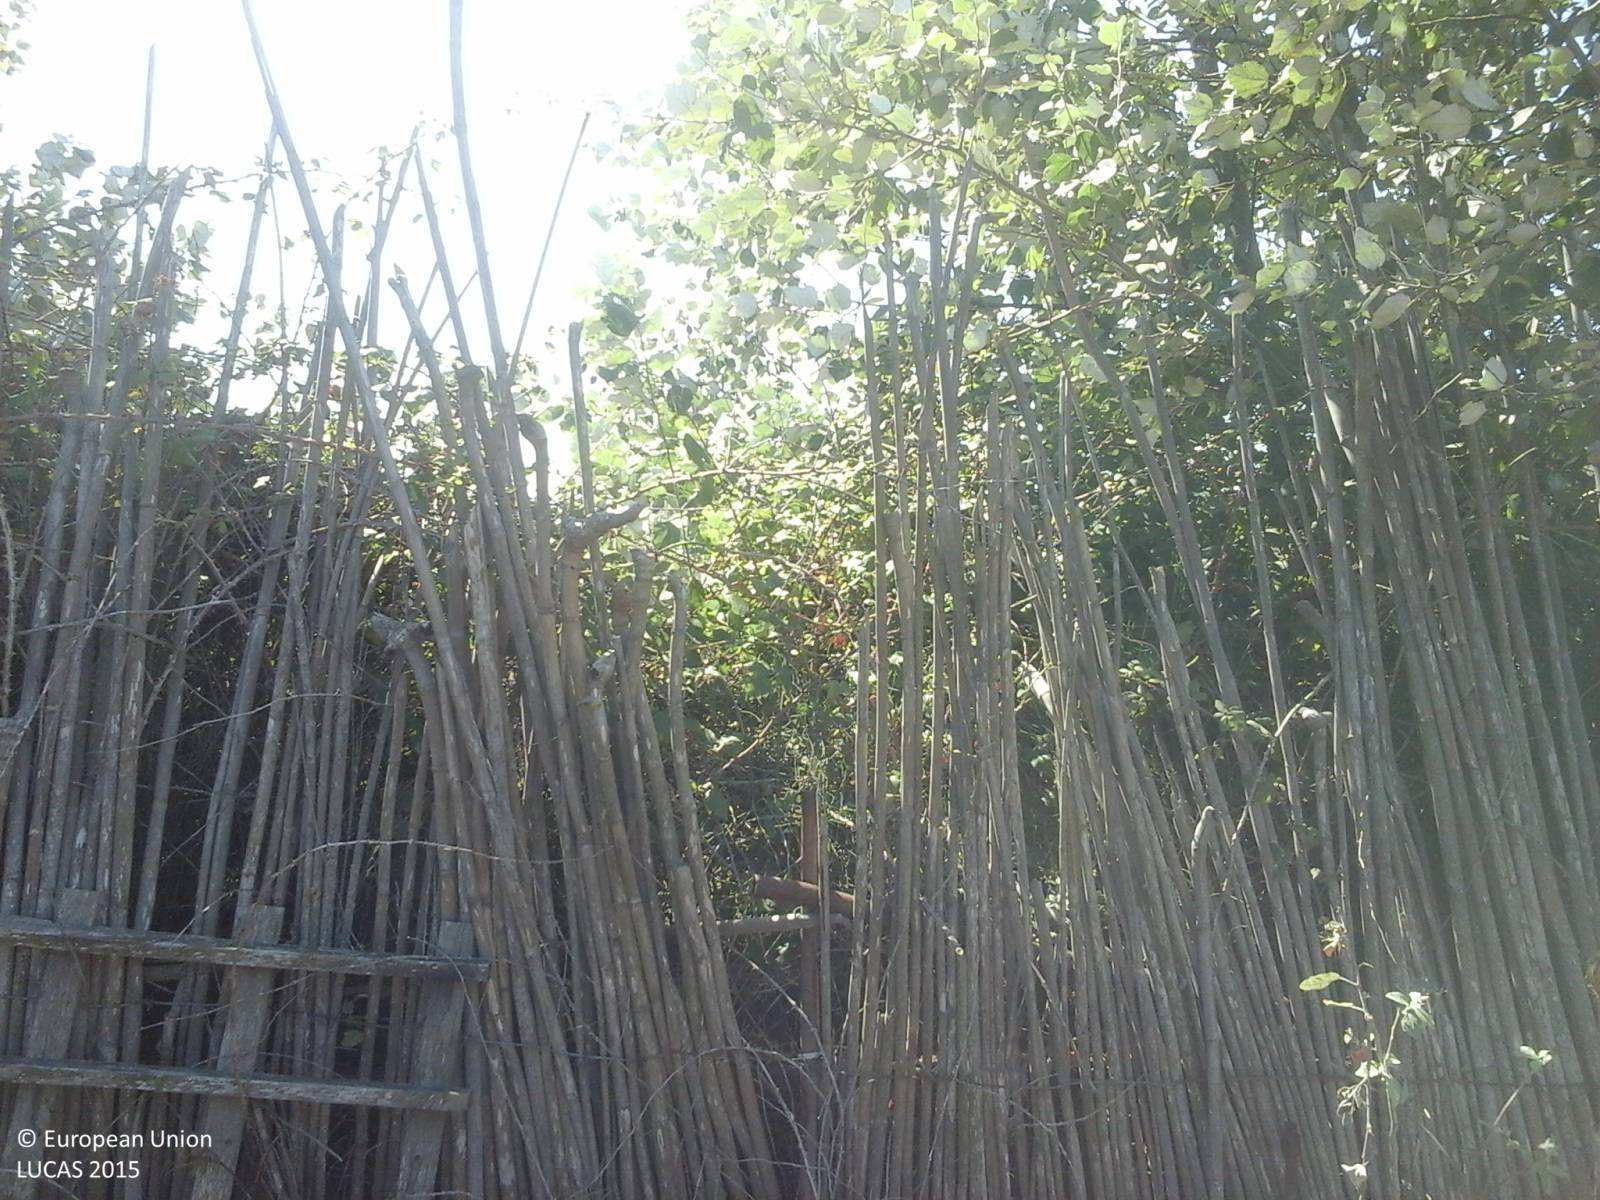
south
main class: Grassland
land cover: Spontaneously vegetated surfaces
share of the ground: > 75 %
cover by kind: herbaceous plants 85 %, unconsolidated bare surface 15 %
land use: Fallow land
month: July
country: IT
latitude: 39.2217
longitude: 8.3998
